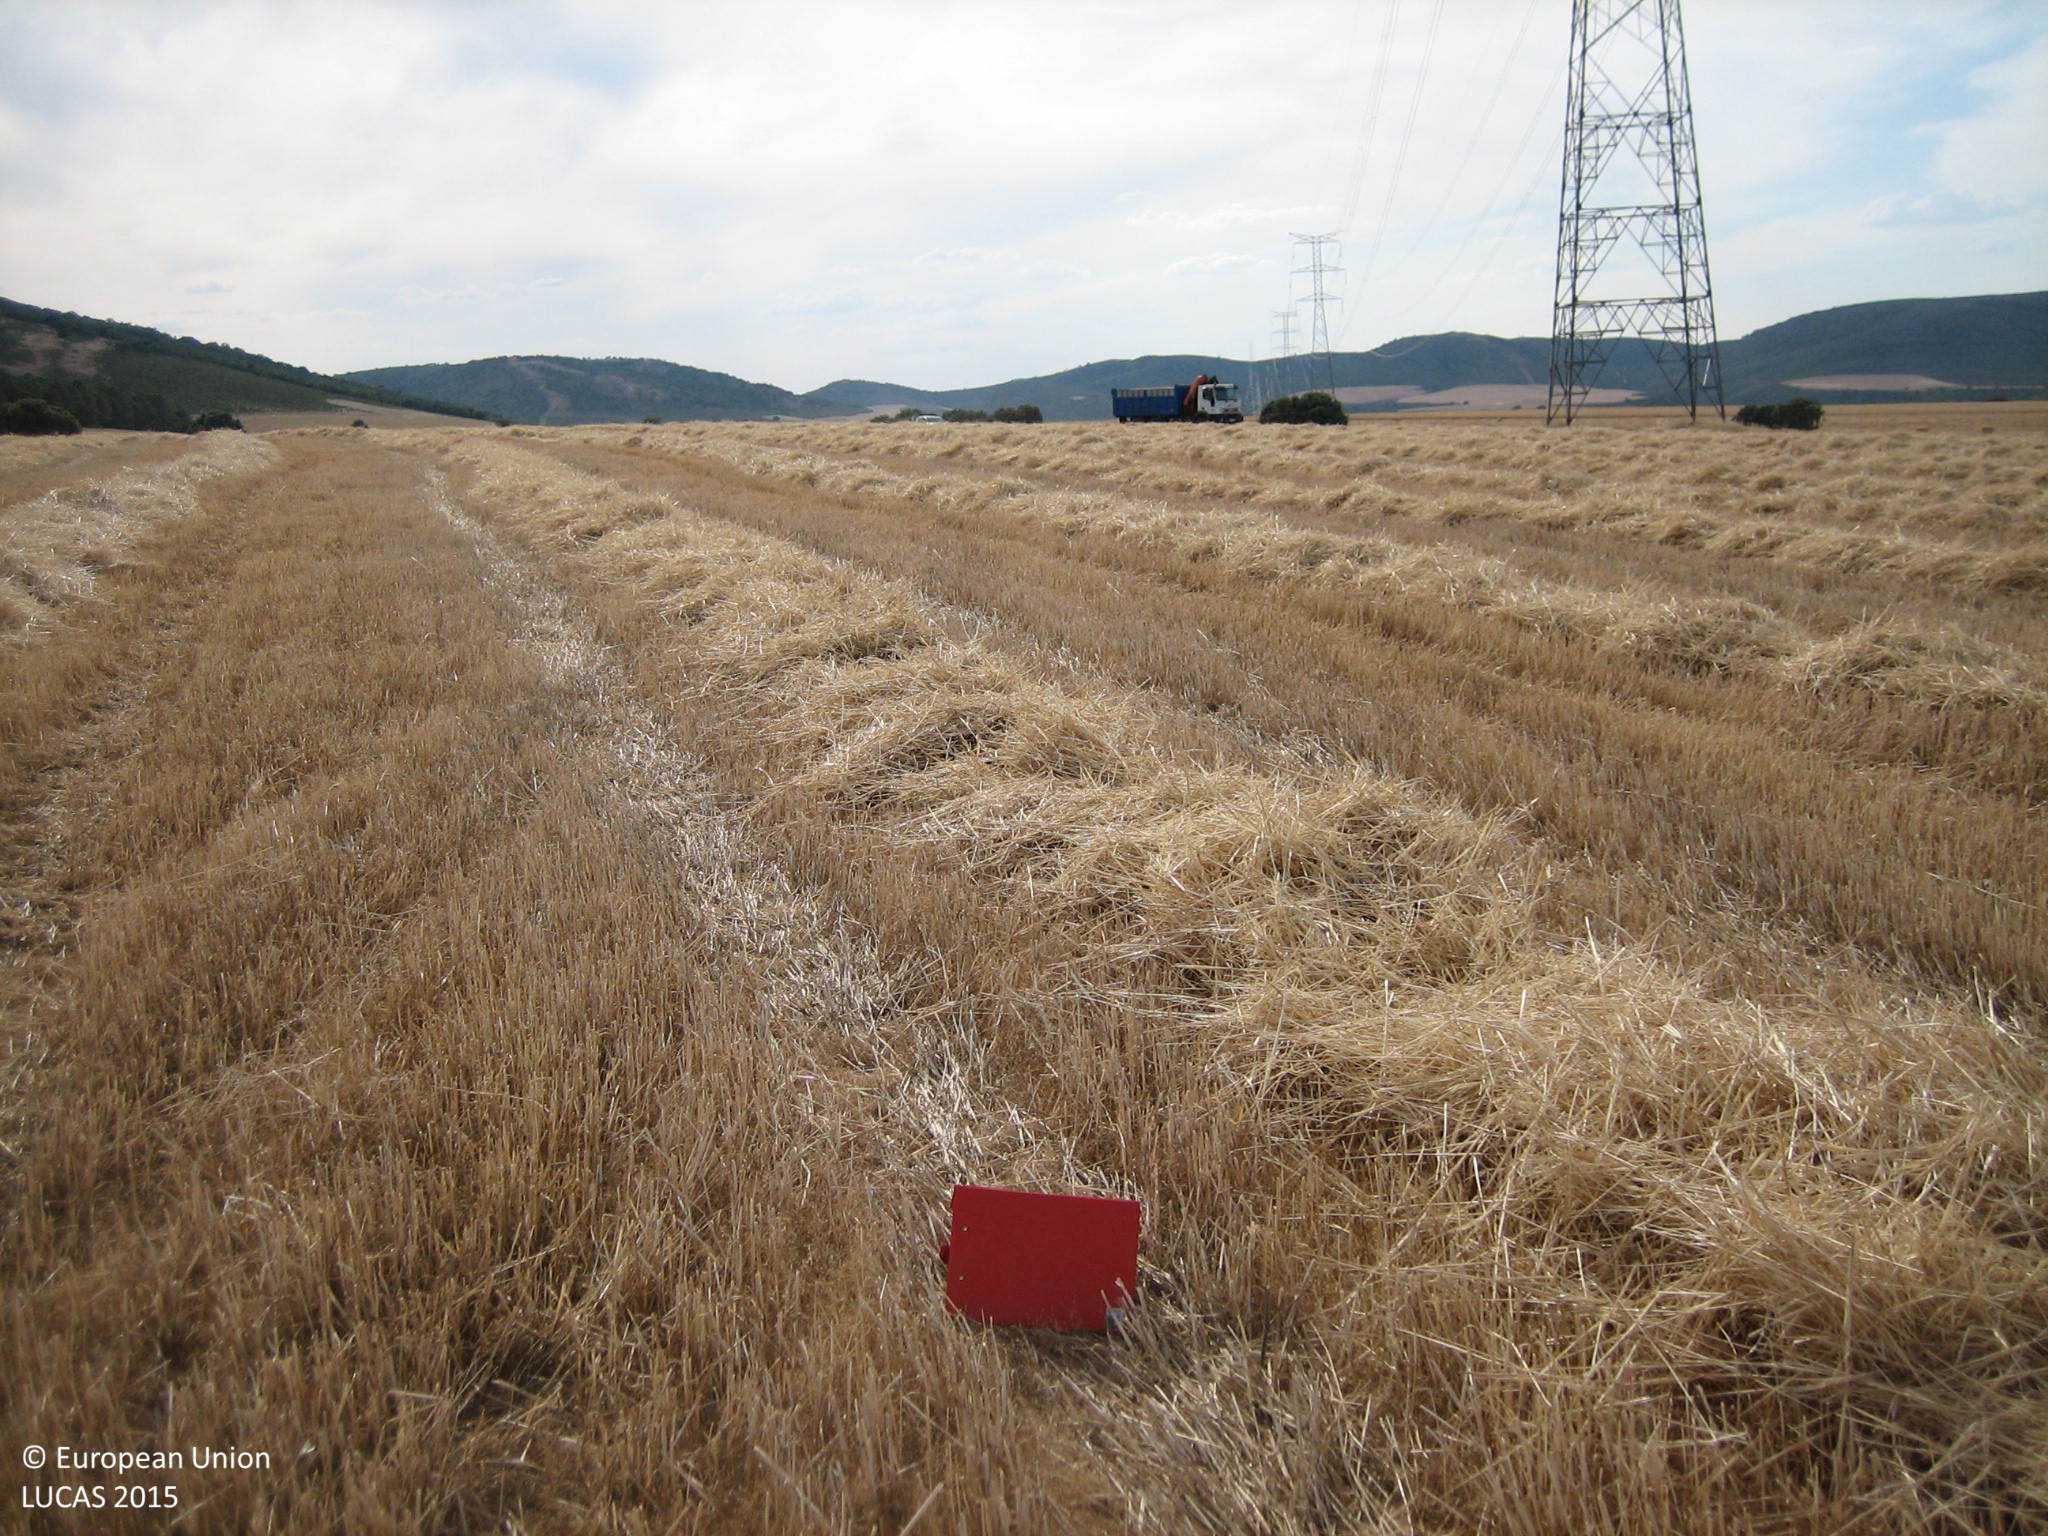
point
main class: Cropland
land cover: Durum wheat
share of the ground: 10 - 25 %
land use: Agriculture (excluding fallow land and kitchen gardens)
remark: Harvested field
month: June
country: ES
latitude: 39.0939
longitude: -4.7283
